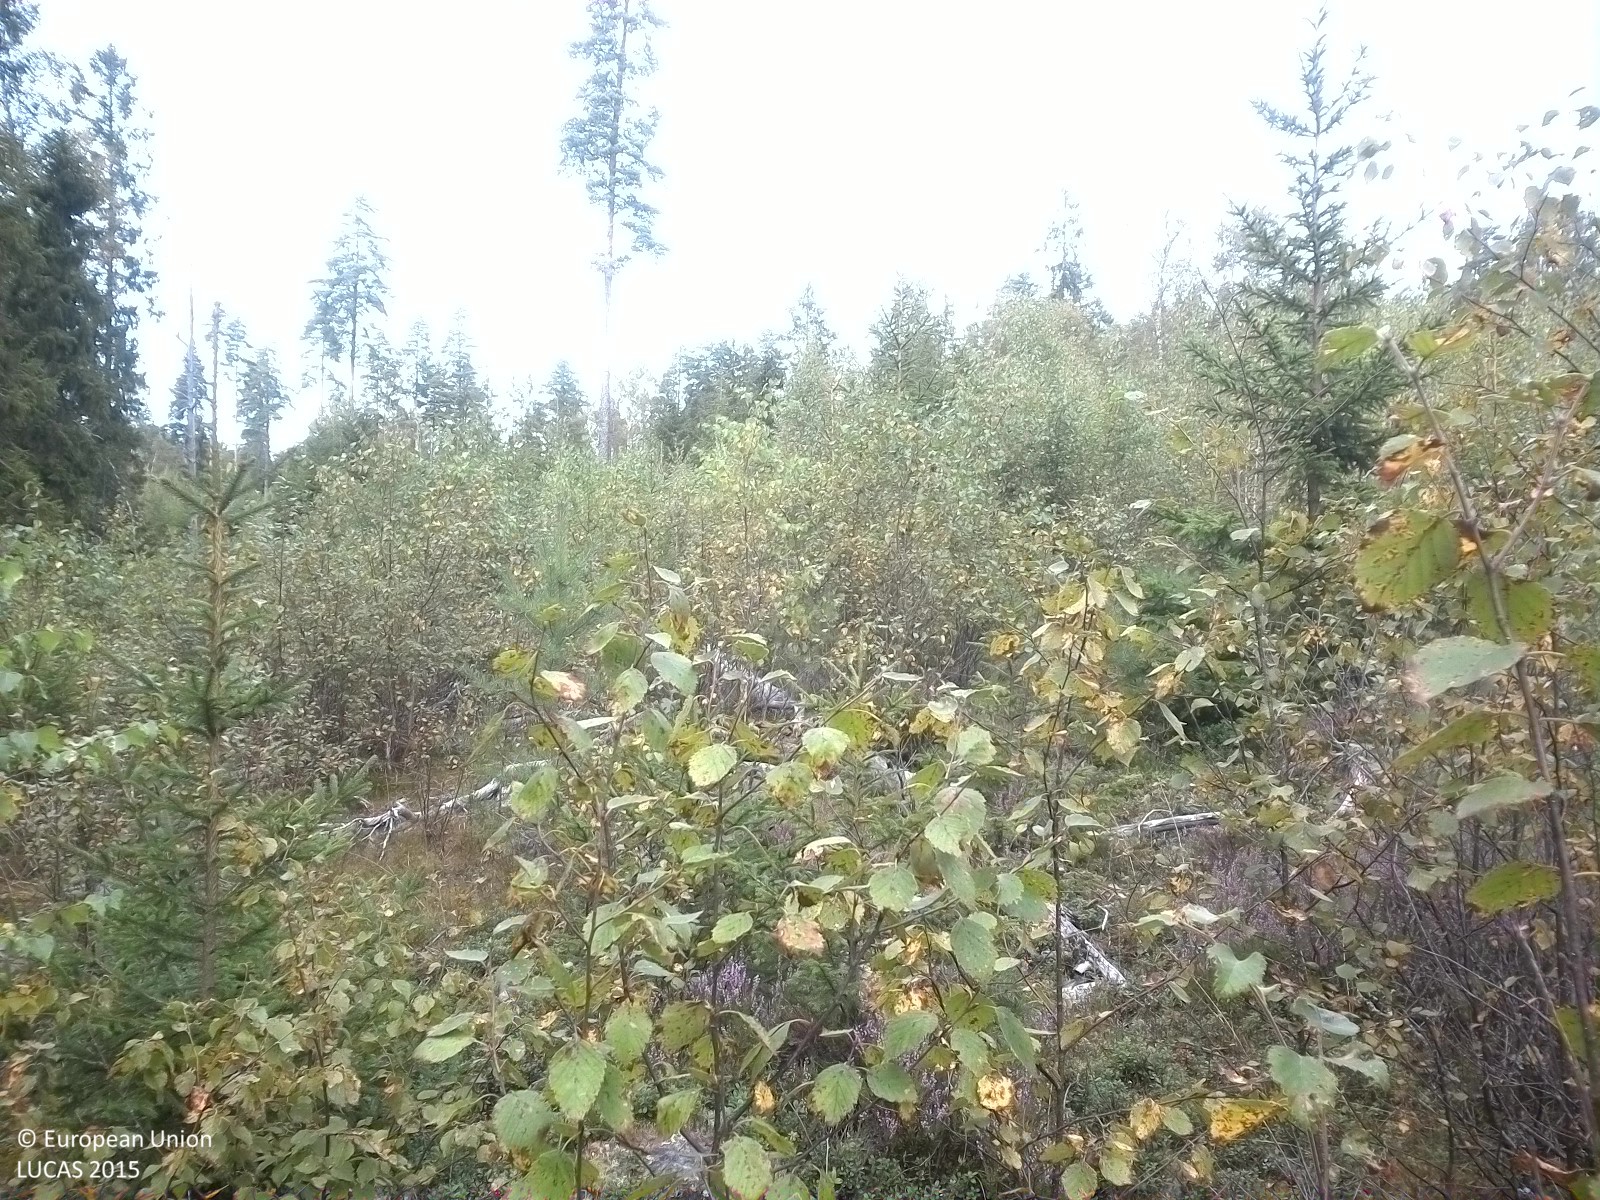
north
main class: Woodland
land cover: Spruce dominated mixed woodland
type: boreal forest
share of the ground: 50 - 75 %
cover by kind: coniferous forest trees 35 %, broadleaved forest trees 25 %, herbaceous plants 20 %, shrubs 10 %, lichens and mosses 10 %
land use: Forestry
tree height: < 5 m
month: August
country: SE
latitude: 59.3539
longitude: 15.8841
